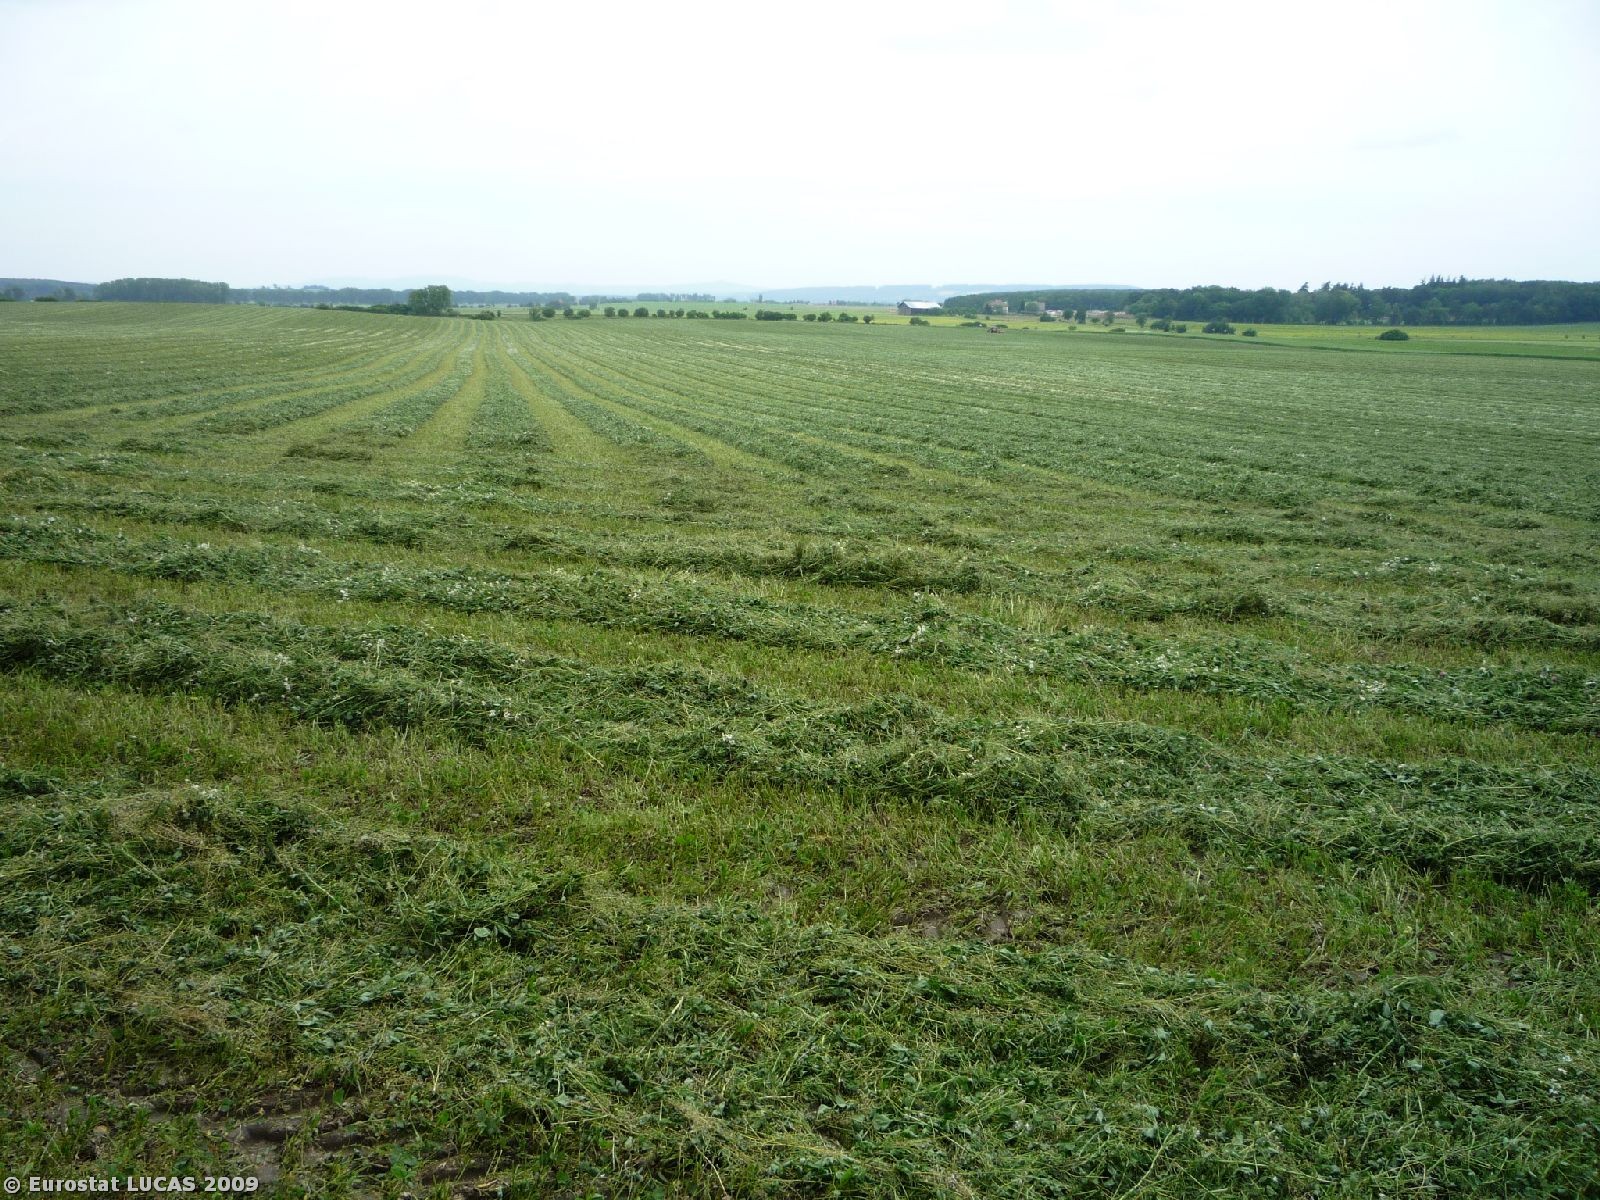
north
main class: Cropland
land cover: Clovers
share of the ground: > 75 %
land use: Agriculture (excluding fallow land and kitchen gardens)
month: May
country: CZ
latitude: 50.3028
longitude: 15.5218
